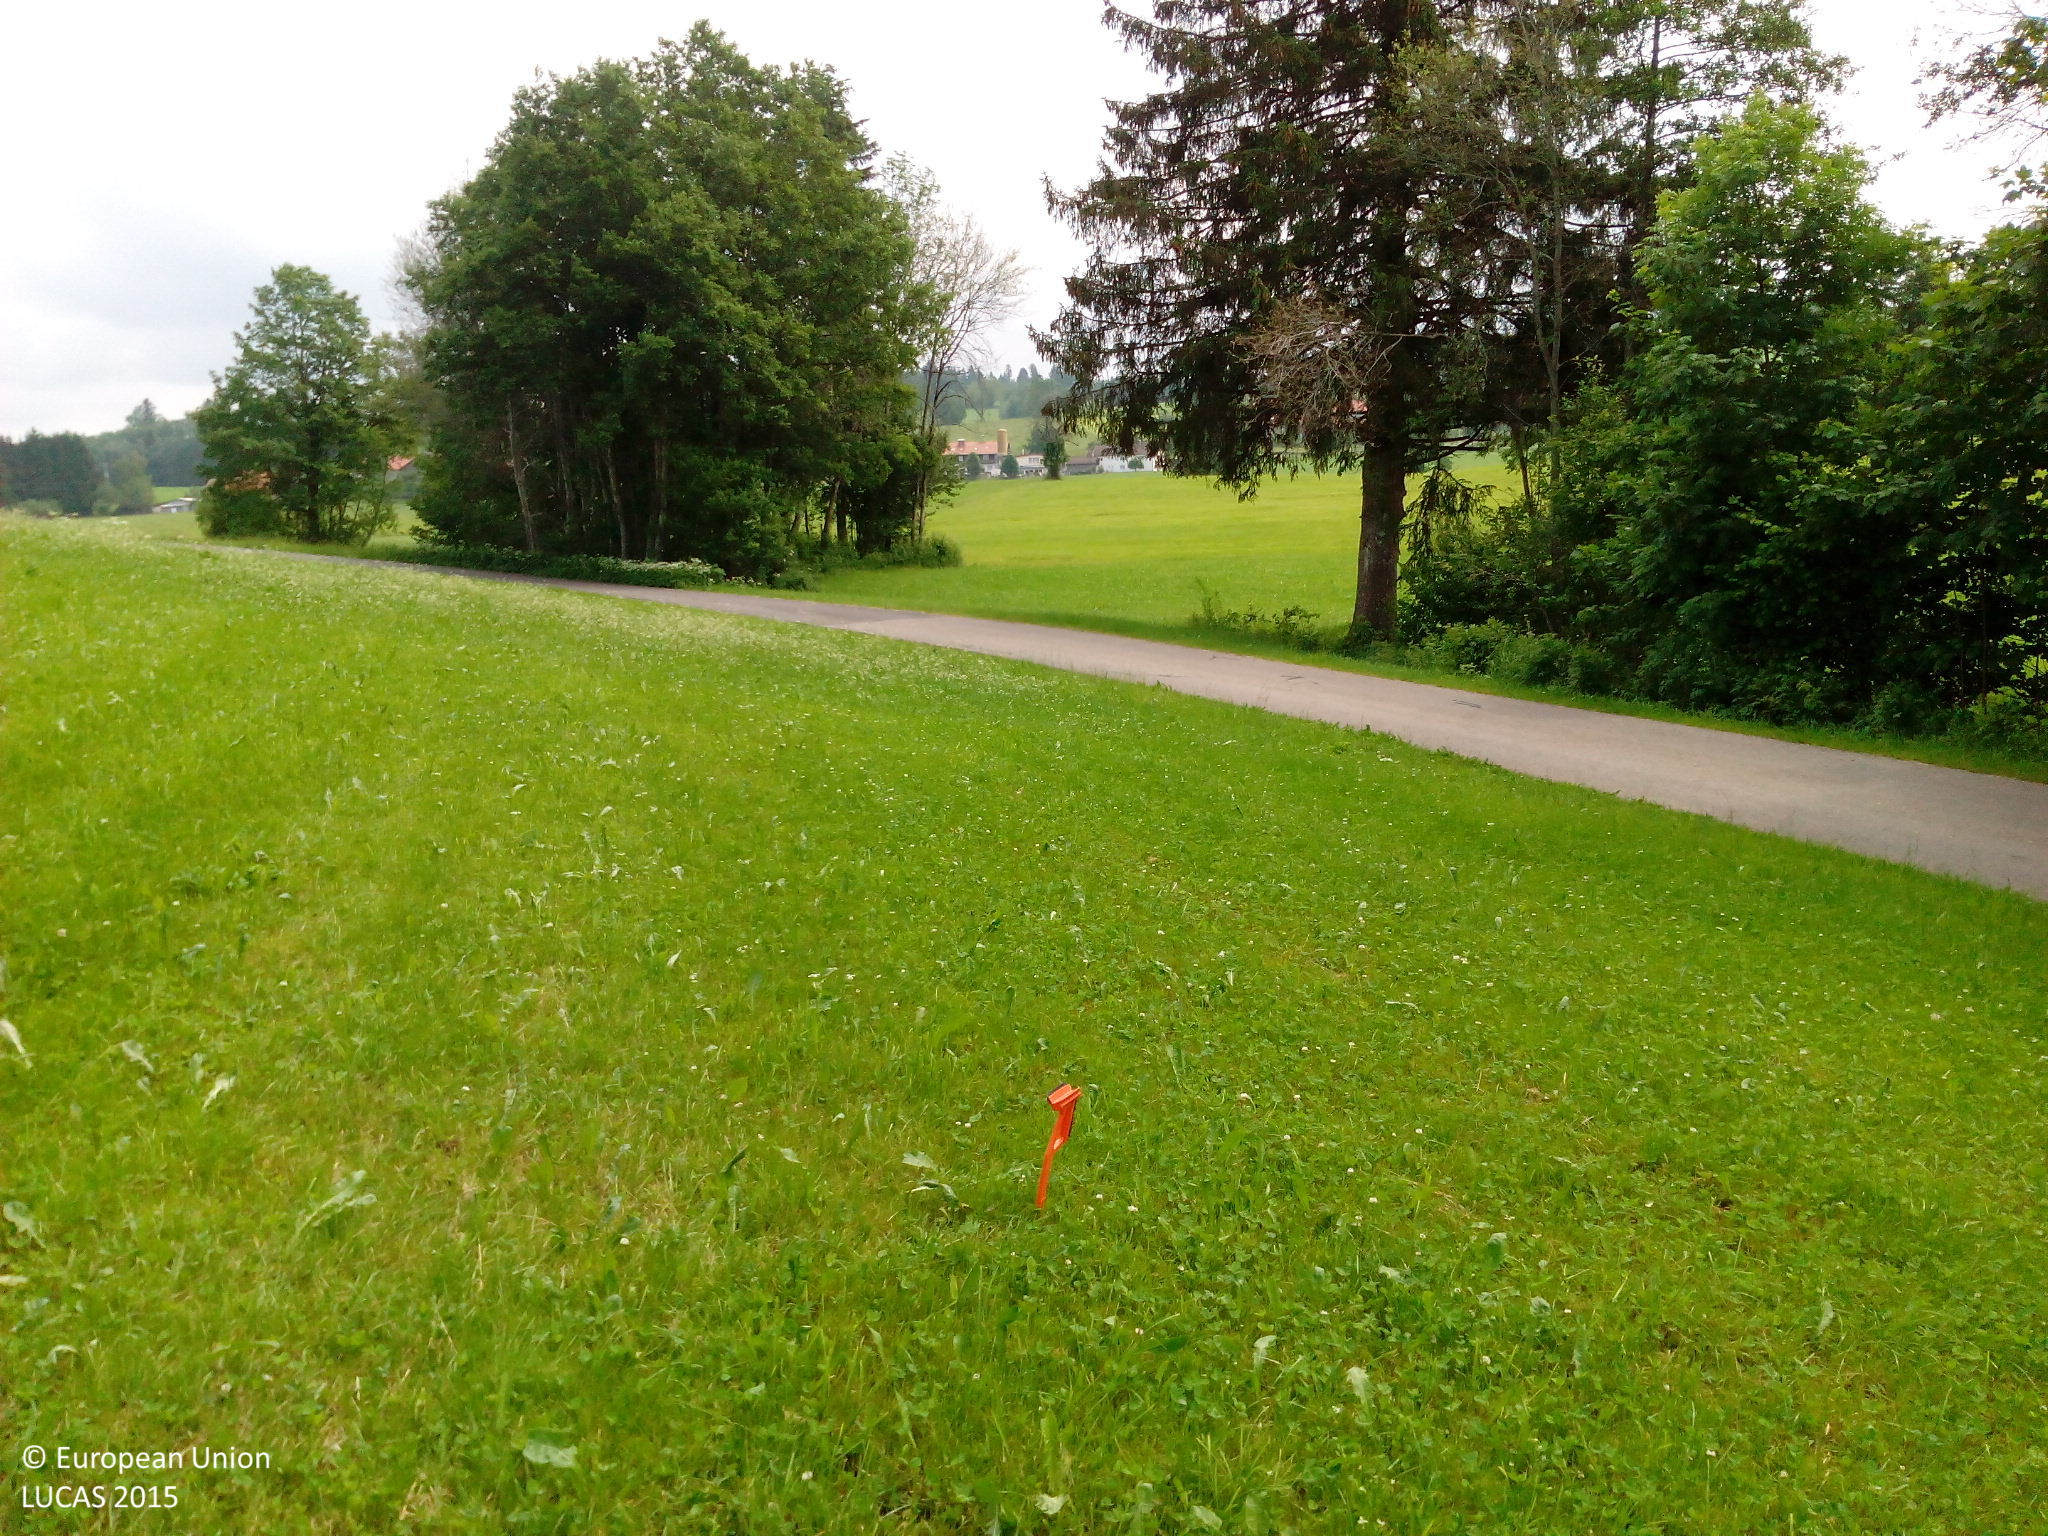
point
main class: Grassland
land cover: Grassland without tree/shrub cover
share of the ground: > 75 %
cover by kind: herbaceous plants 100 %
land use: Agriculture (excluding fallow land and kitchen gardens)
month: June
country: DE
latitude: 47.5576
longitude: 9.9336
